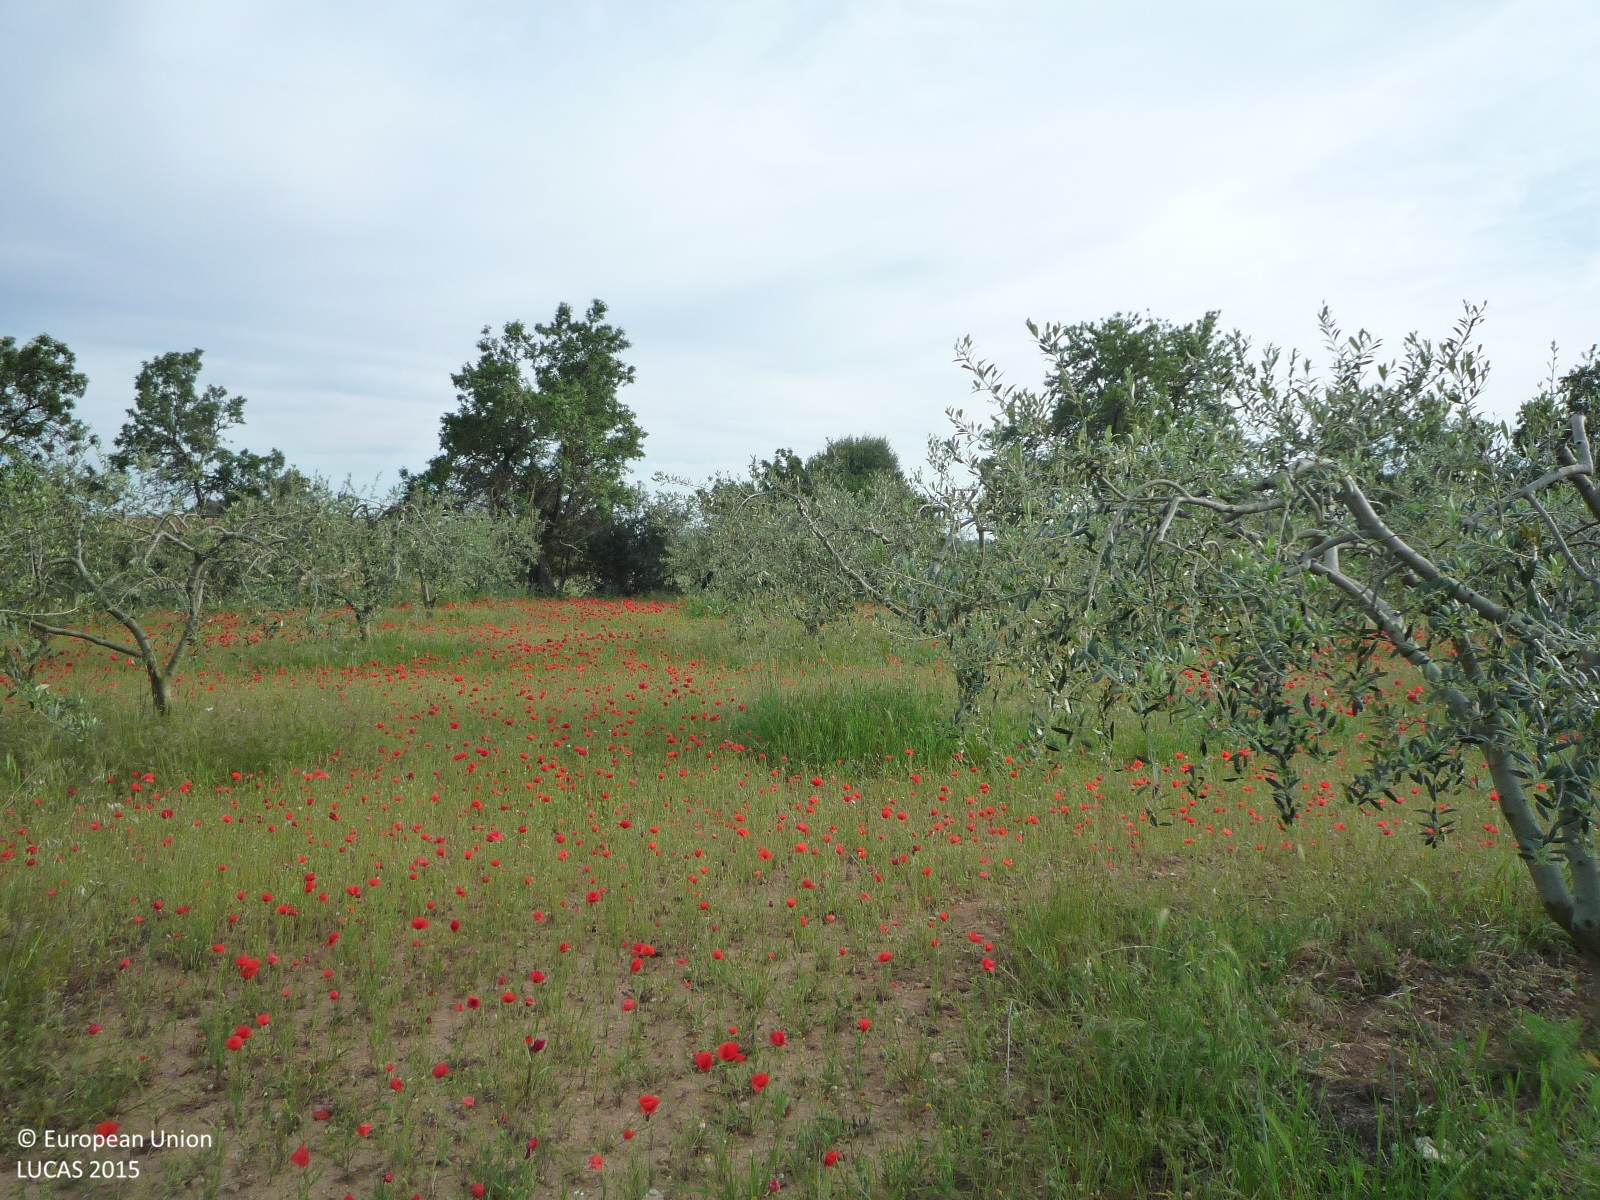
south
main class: Cropland
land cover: Olive groves
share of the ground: 25 - 50 %
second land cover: Spontaneously vegetated surfaces
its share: > 75 %
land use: Agriculture (excluding fallow land and kitchen gardens)
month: April
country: ES
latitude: 41.3237
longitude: 1.5945
